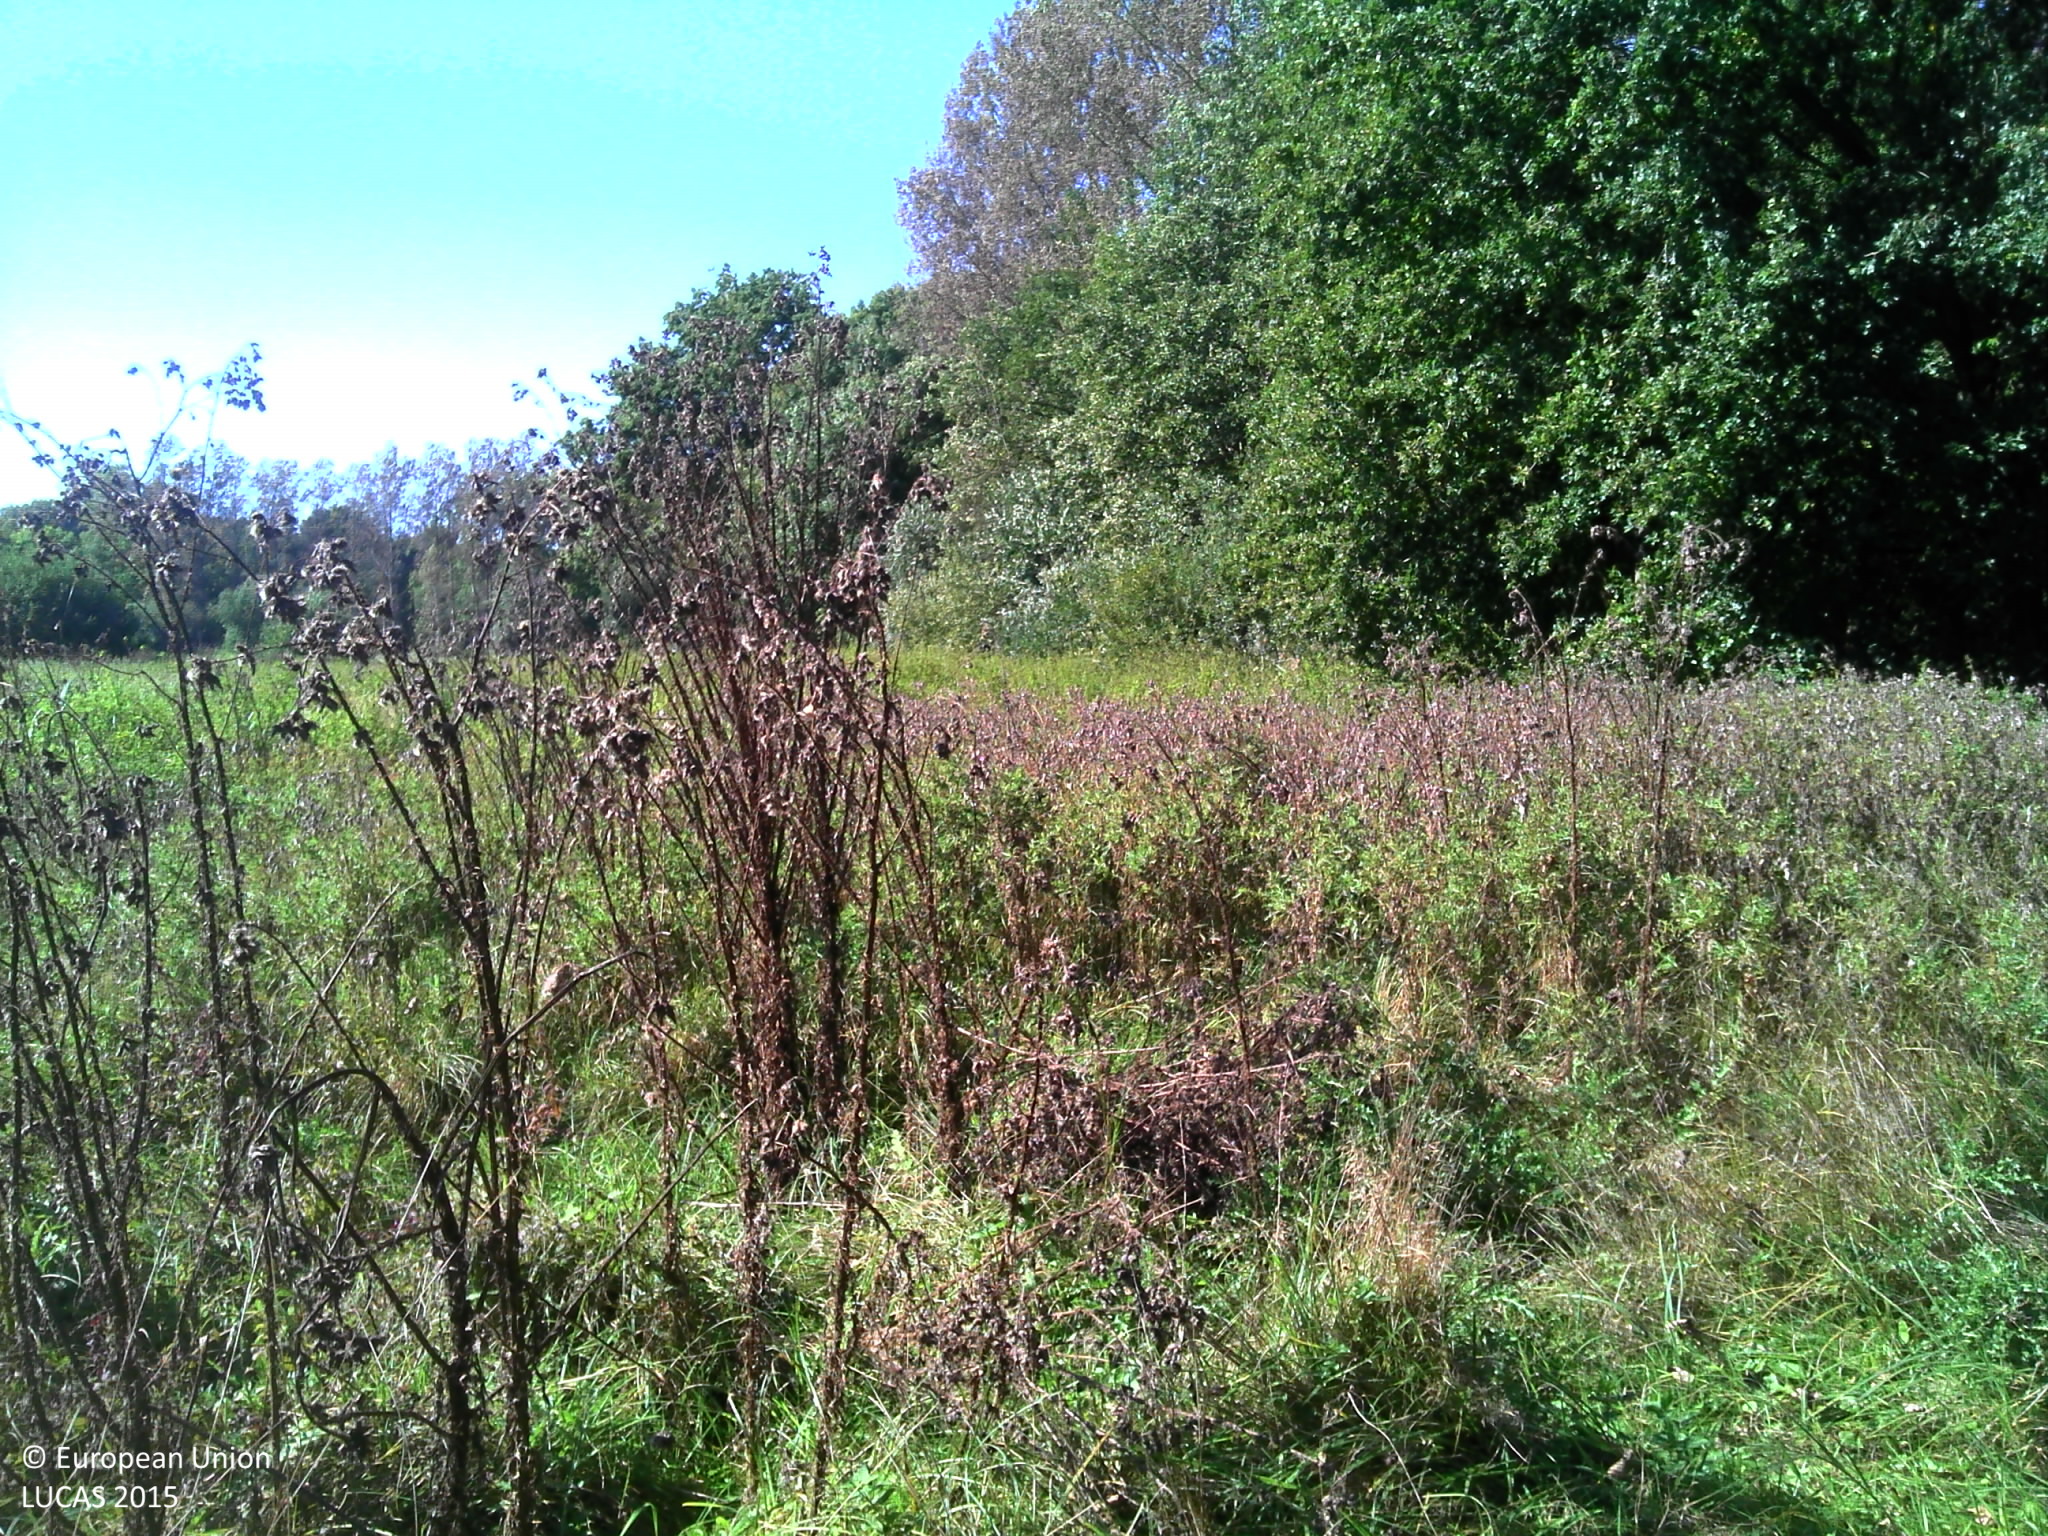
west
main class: Grassland
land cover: Spontaneously vegetated surfaces
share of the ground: > 75 %
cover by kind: herbaceous plants 100 %
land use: Semi-natural and natural areas not in use
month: September
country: BE
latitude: 51.1829
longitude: 4.8035
